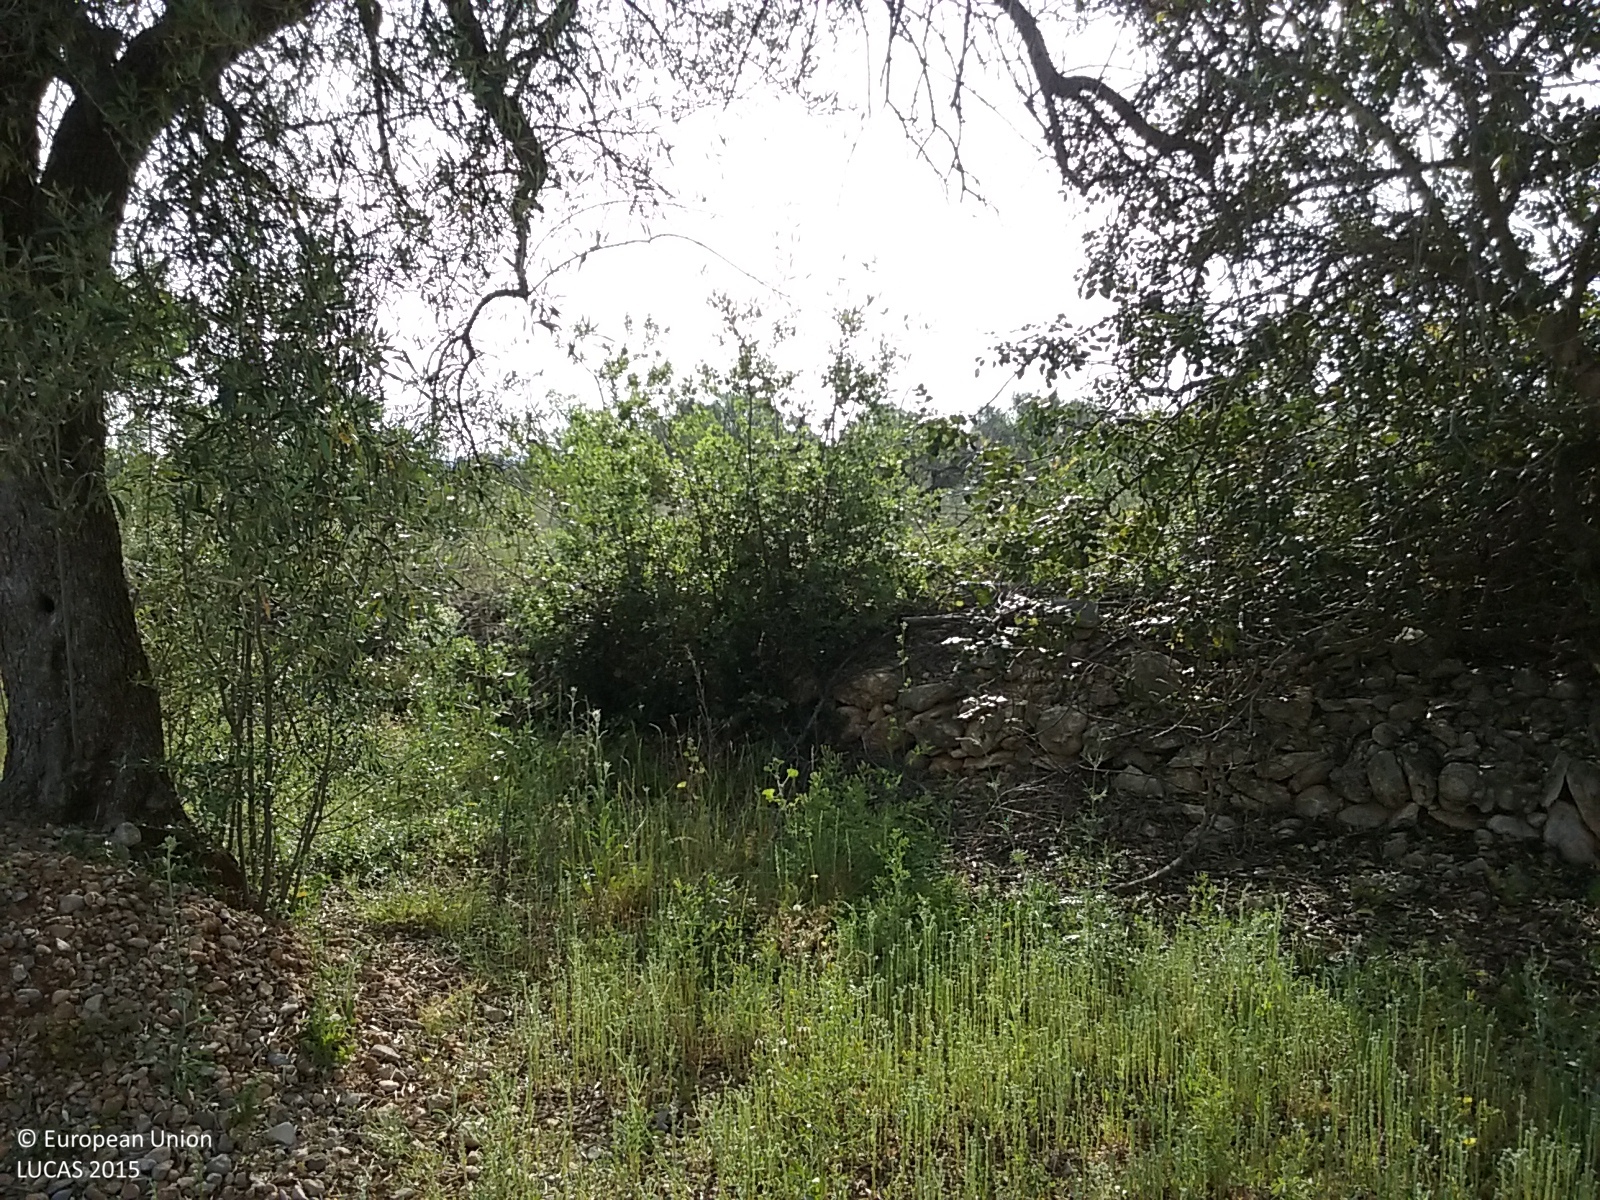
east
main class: Cropland
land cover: Olive groves
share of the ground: 25 - 50 %
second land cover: Grassland without tree/shrub cover
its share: > 75 %
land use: Agriculture (excluding fallow land and kitchen gardens)
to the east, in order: Olive groves; Grassland without tree/shrub cover; Dry stone walls; Nuts trees; Dry stone walls; Olive groves; Dry stone walls; Nuts trees; Dry stone walls; Single bushes/trees; Nuts trees; Dry stone walls; Olive groves
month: May
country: ES
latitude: 40.6065
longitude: 0.3154
